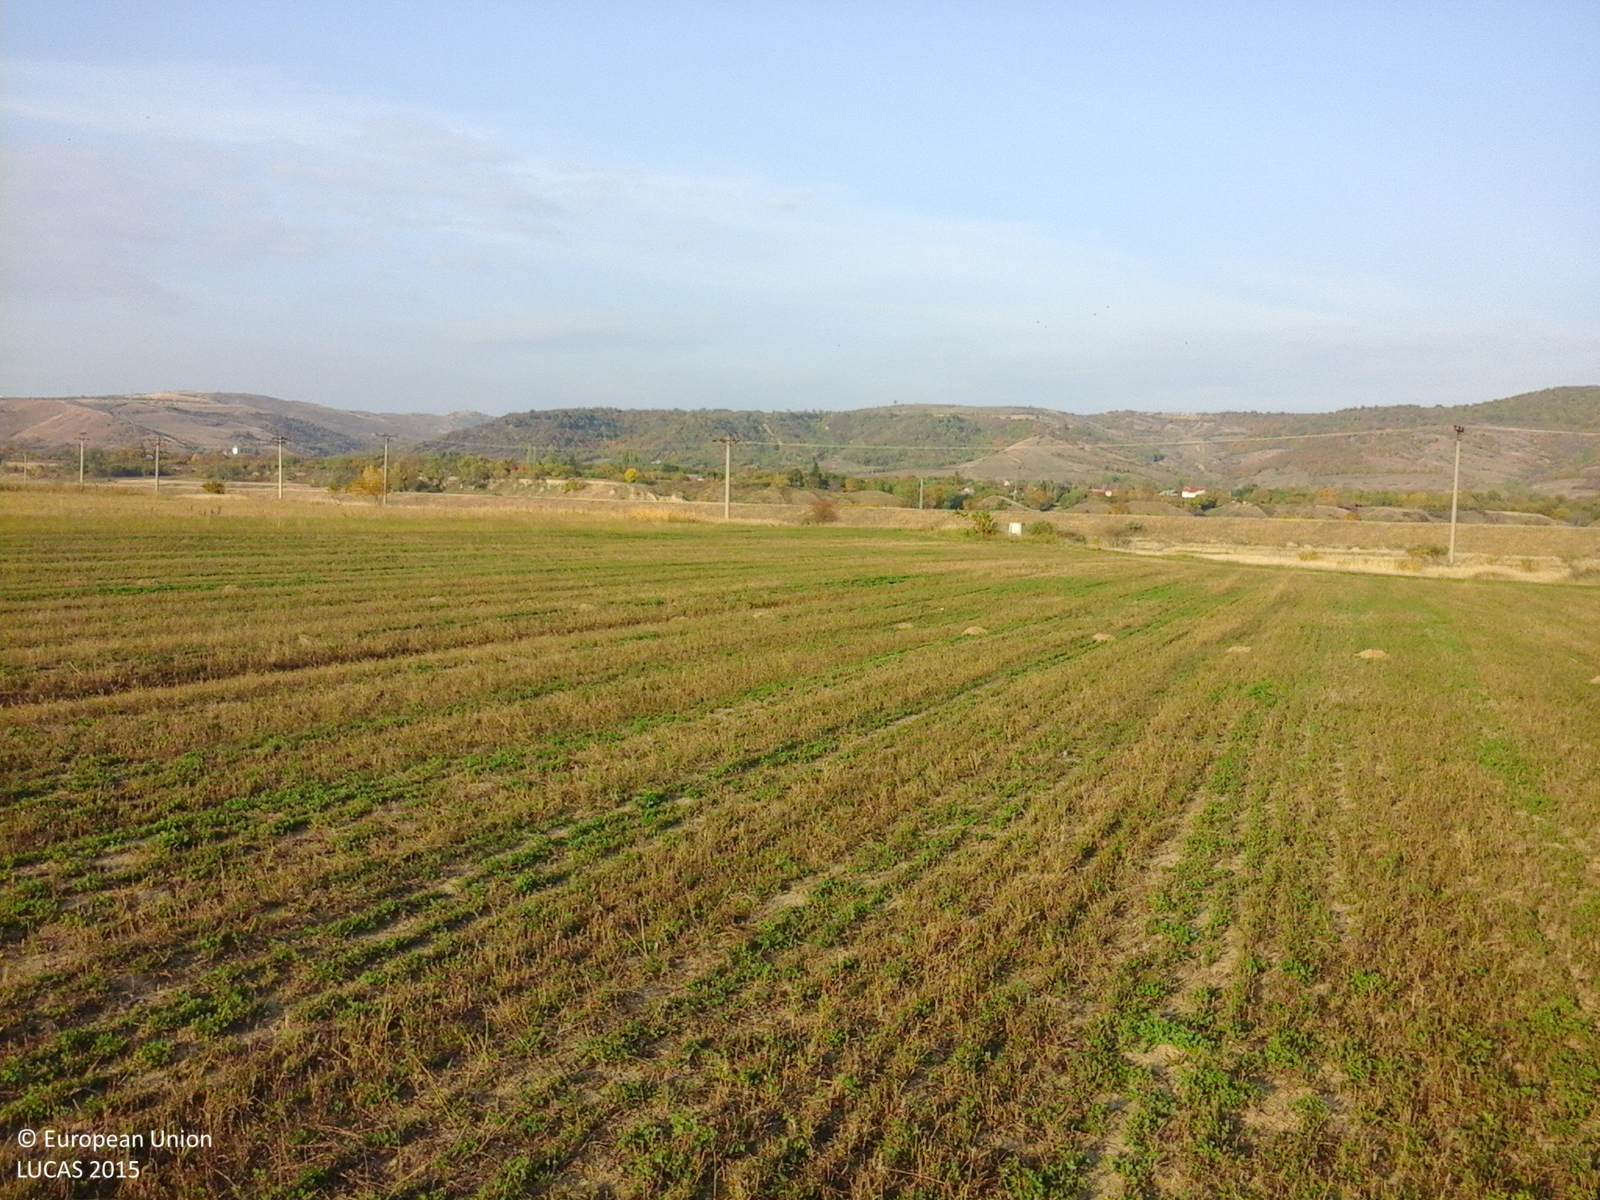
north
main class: Cropland
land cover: Lucerne
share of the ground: 50 - 75 %
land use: Agriculture (excluding fallow land and kitchen gardens)
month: October
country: RO
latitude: 45.2638
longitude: 26.7094
